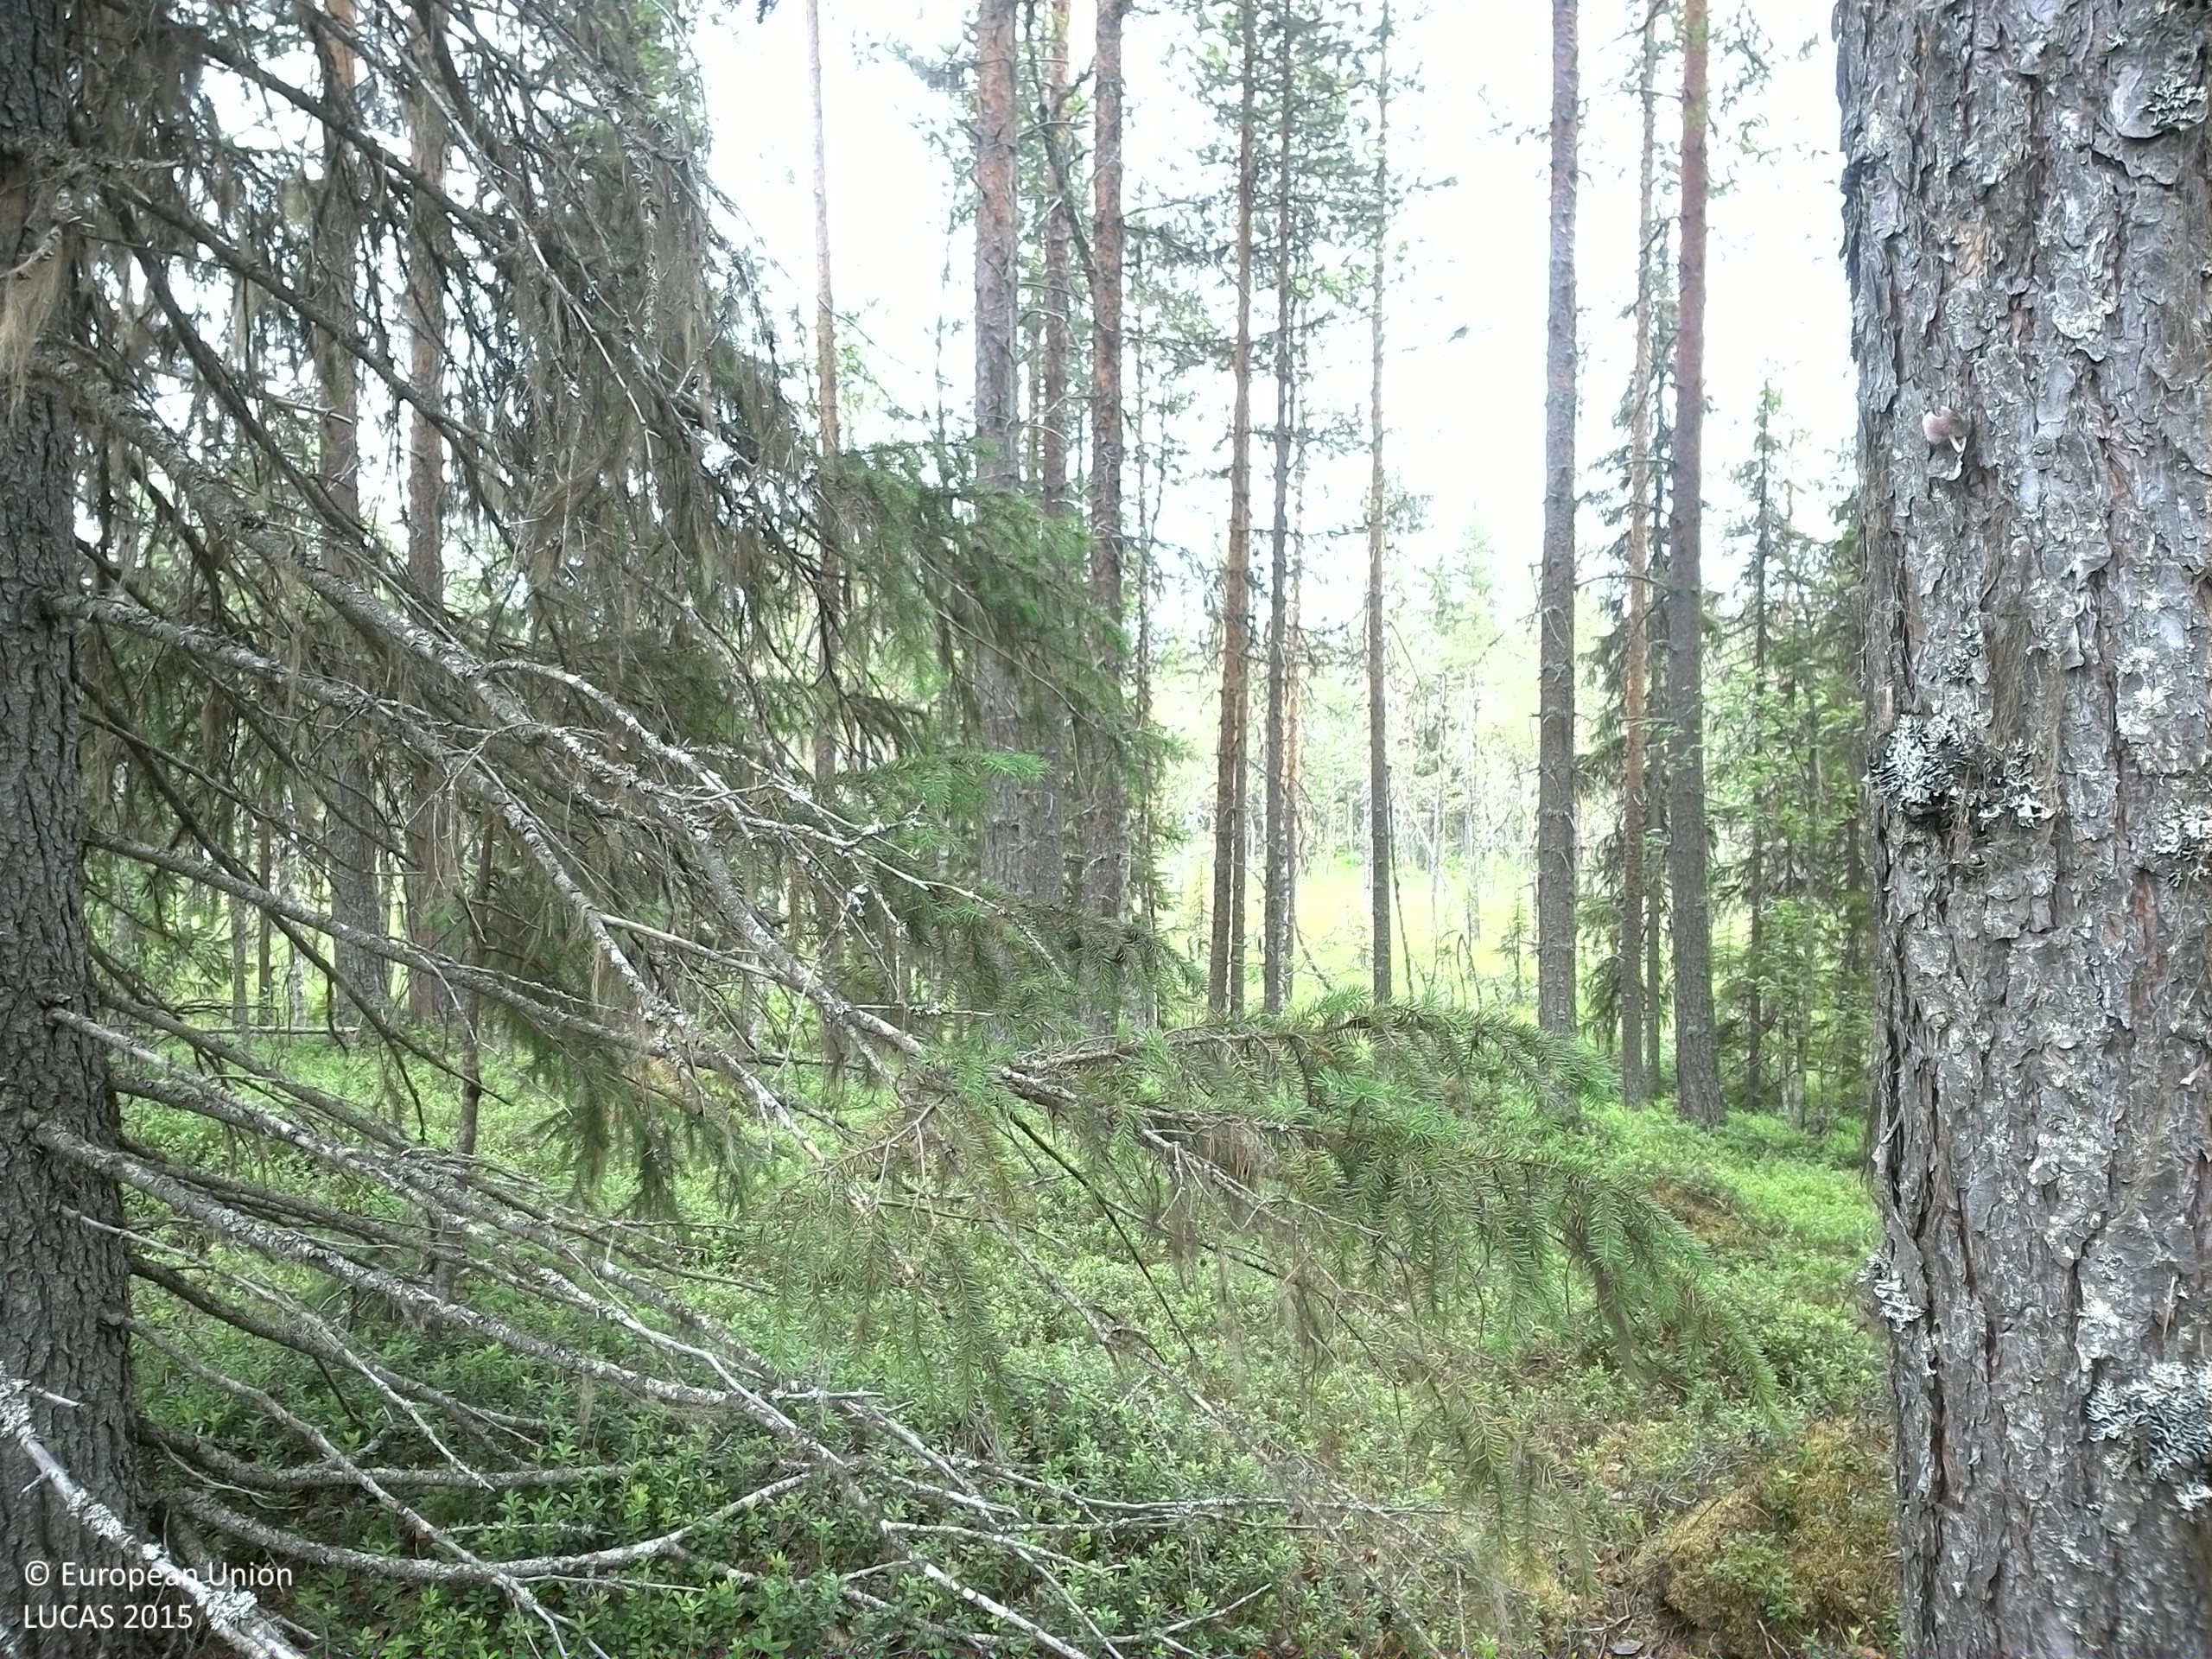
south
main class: Woodland
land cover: Pine dominated mixed woodland
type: boreal forest
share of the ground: 50 - 75 %
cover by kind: coniferous forest trees 40 %, shrubs 30 %, broadleaved forest trees 15 %, lichens and mosses 15 %
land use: Forestry
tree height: > 5 m
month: July
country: SE
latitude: 63.6400
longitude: 17.5027
